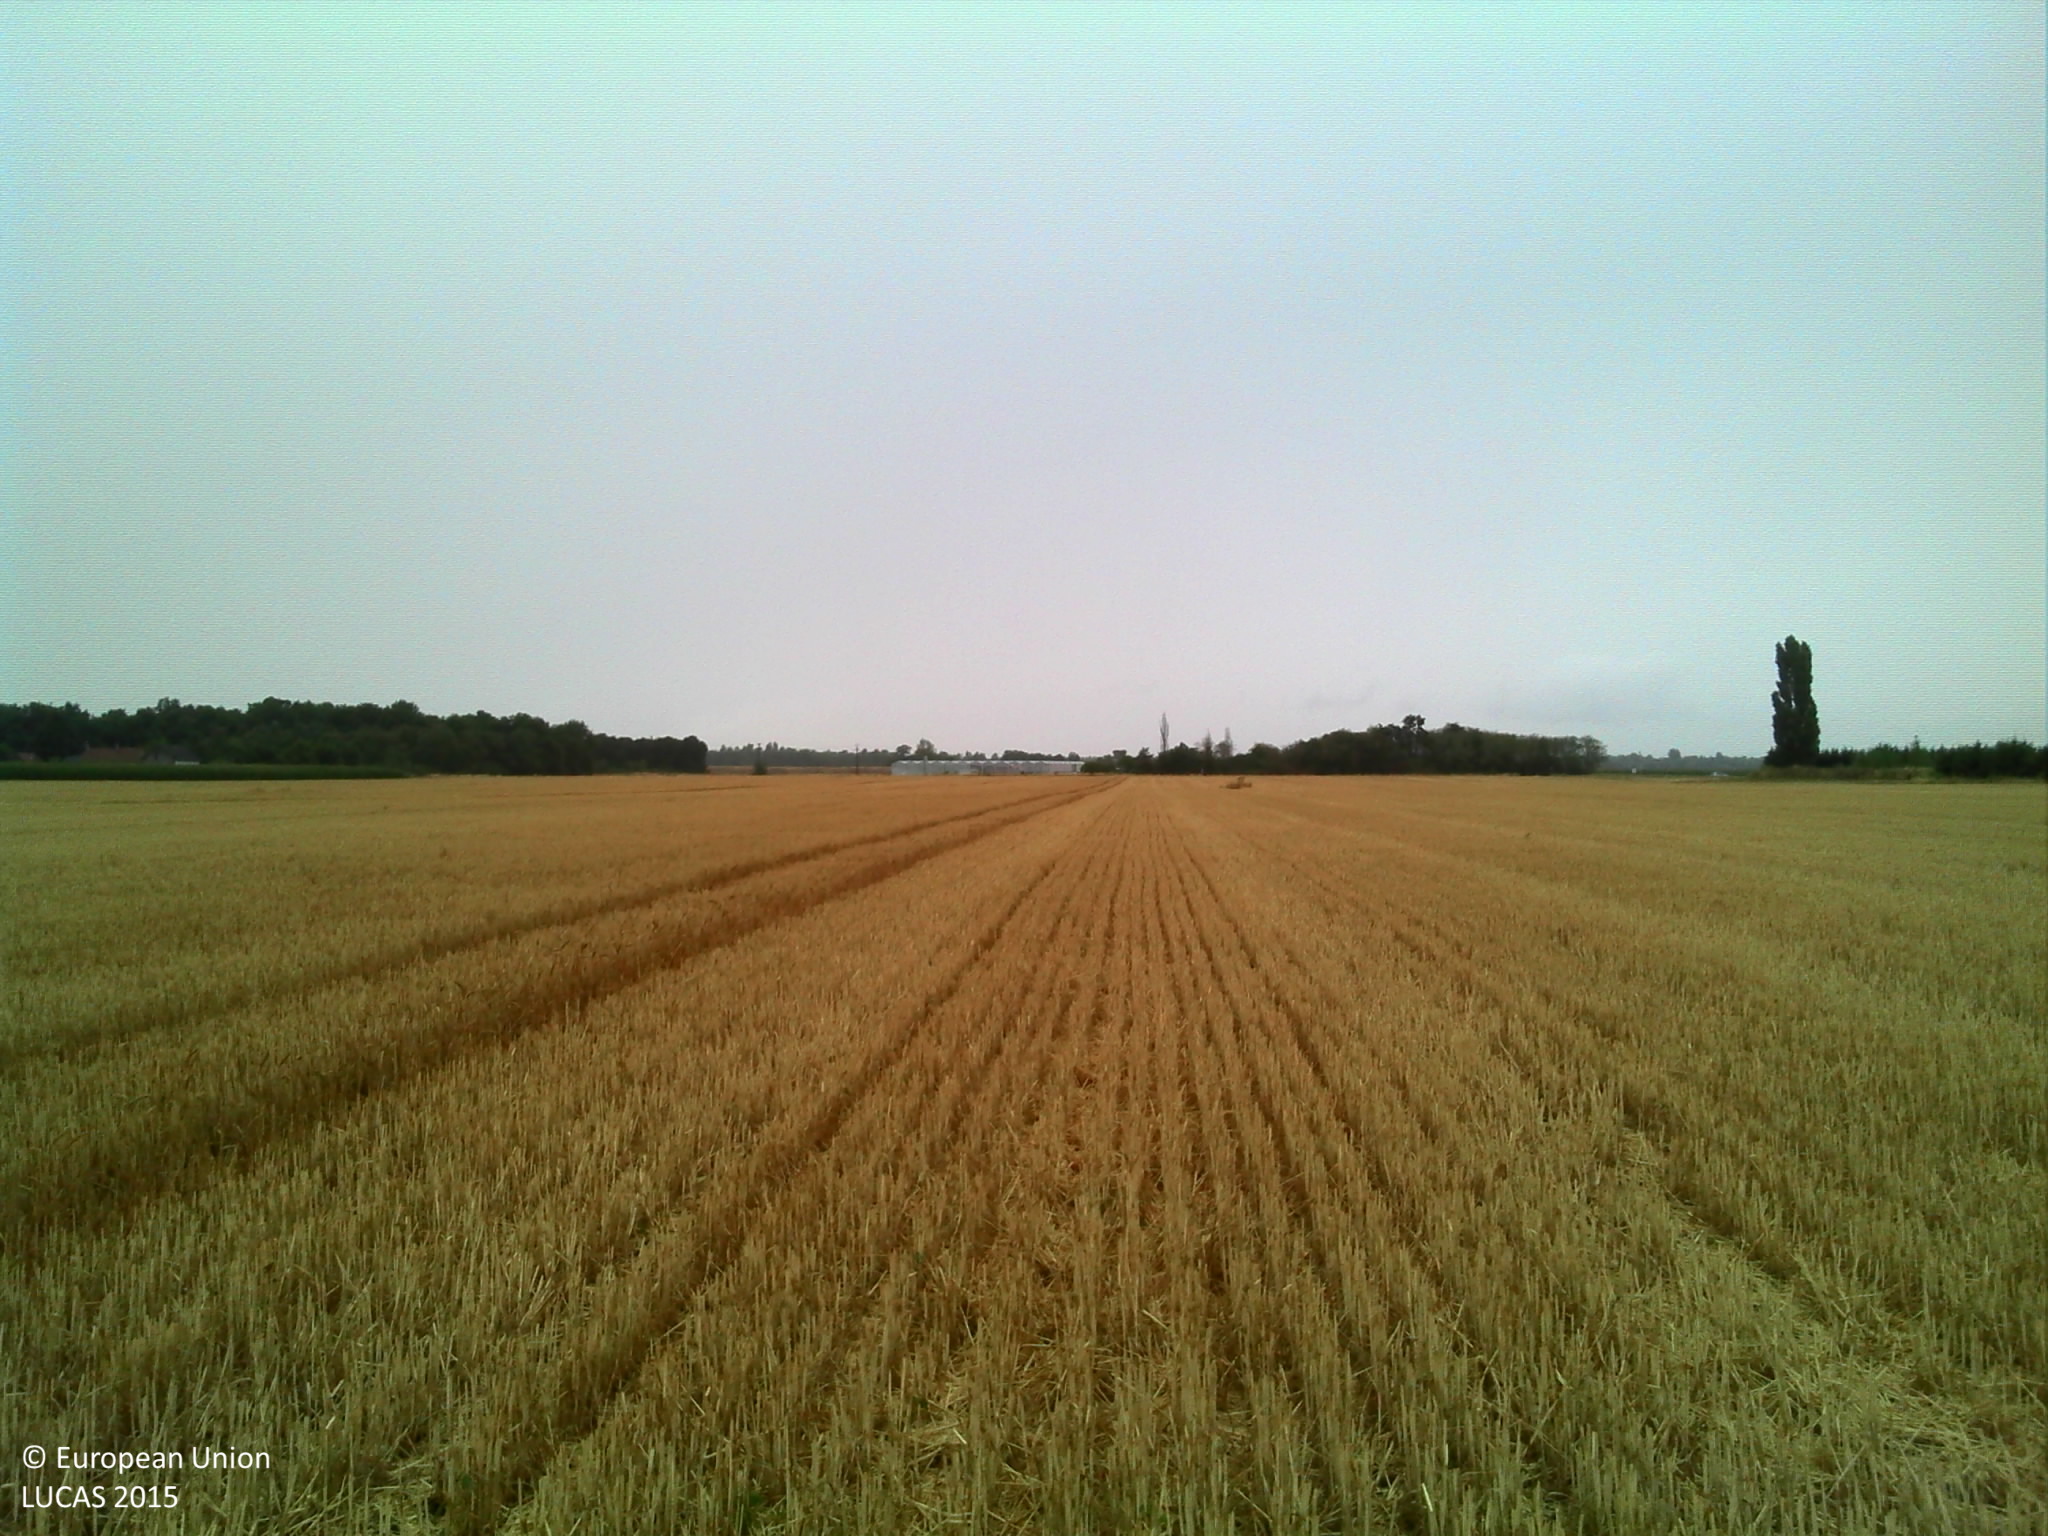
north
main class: Cropland
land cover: Common wheat
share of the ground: > 75 %
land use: Agriculture (excluding fallow land and kitchen gardens)
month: July
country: FR
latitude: 47.8468
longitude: 2.0642
